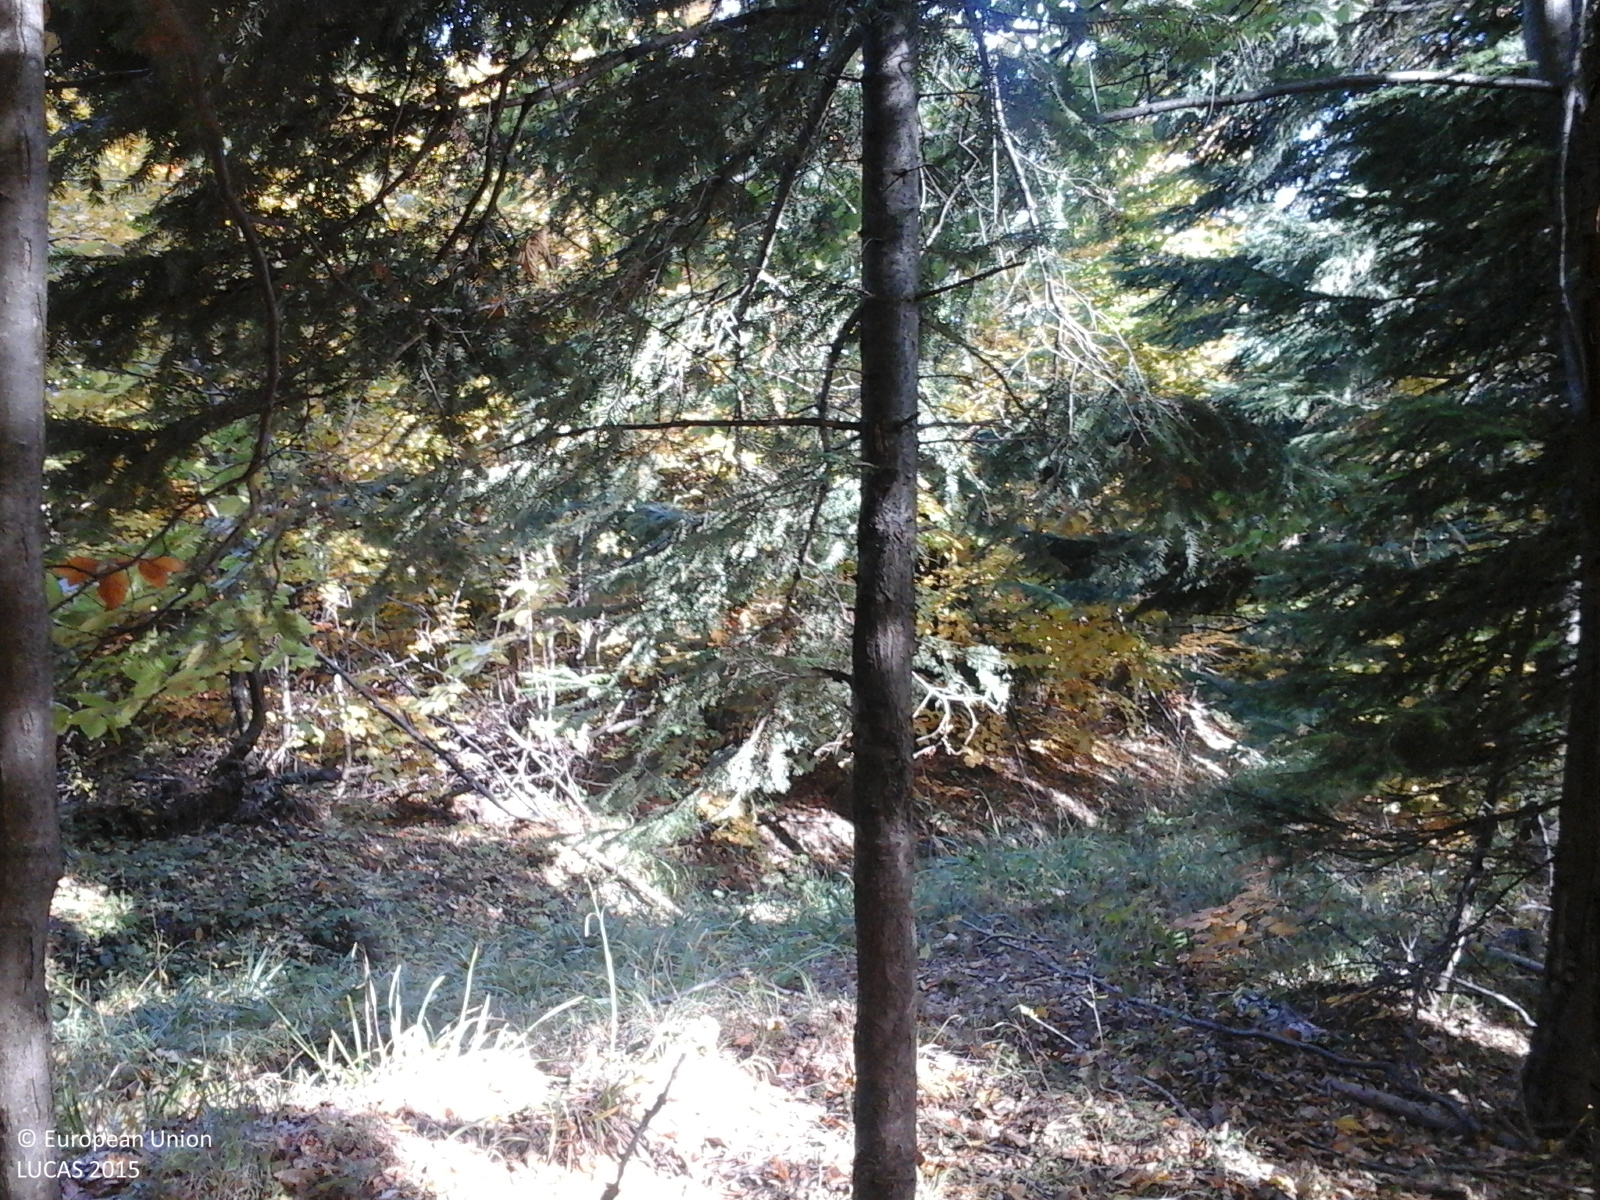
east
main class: Woodland
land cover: Broadleaved woodland
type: beech forest
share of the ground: > 75 %
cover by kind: broadleaved forest trees 100 %
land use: Forestry
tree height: > 5 m
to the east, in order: Broadleaved woodland; Tracks; Broadleaved woodland
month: October
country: RO
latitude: 46.0471
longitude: 26.6372
